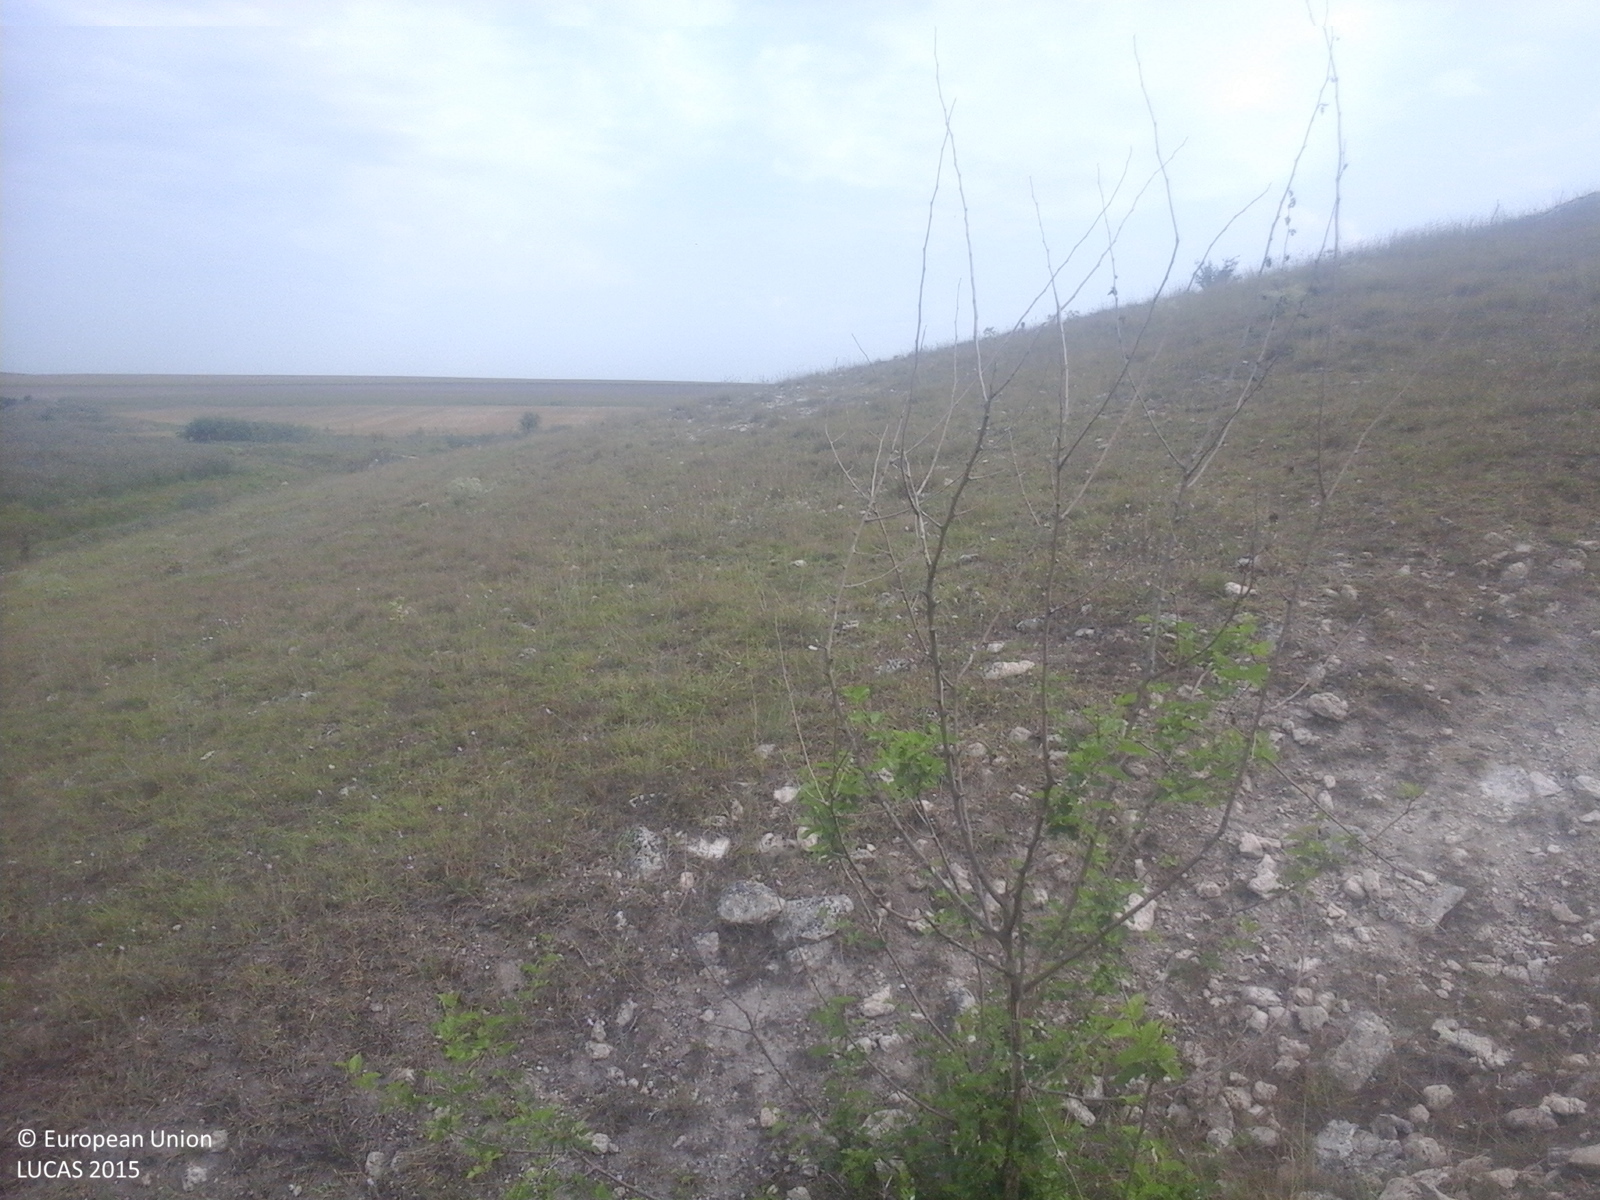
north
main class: Grassland
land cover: Grassland without tree/shrub cover
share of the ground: > 75 %
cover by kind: herbaceous plants 100 %
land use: Agriculture (excluding fallow land and kitchen gardens)
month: August
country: RO
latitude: 43.9623
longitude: 28.1912
